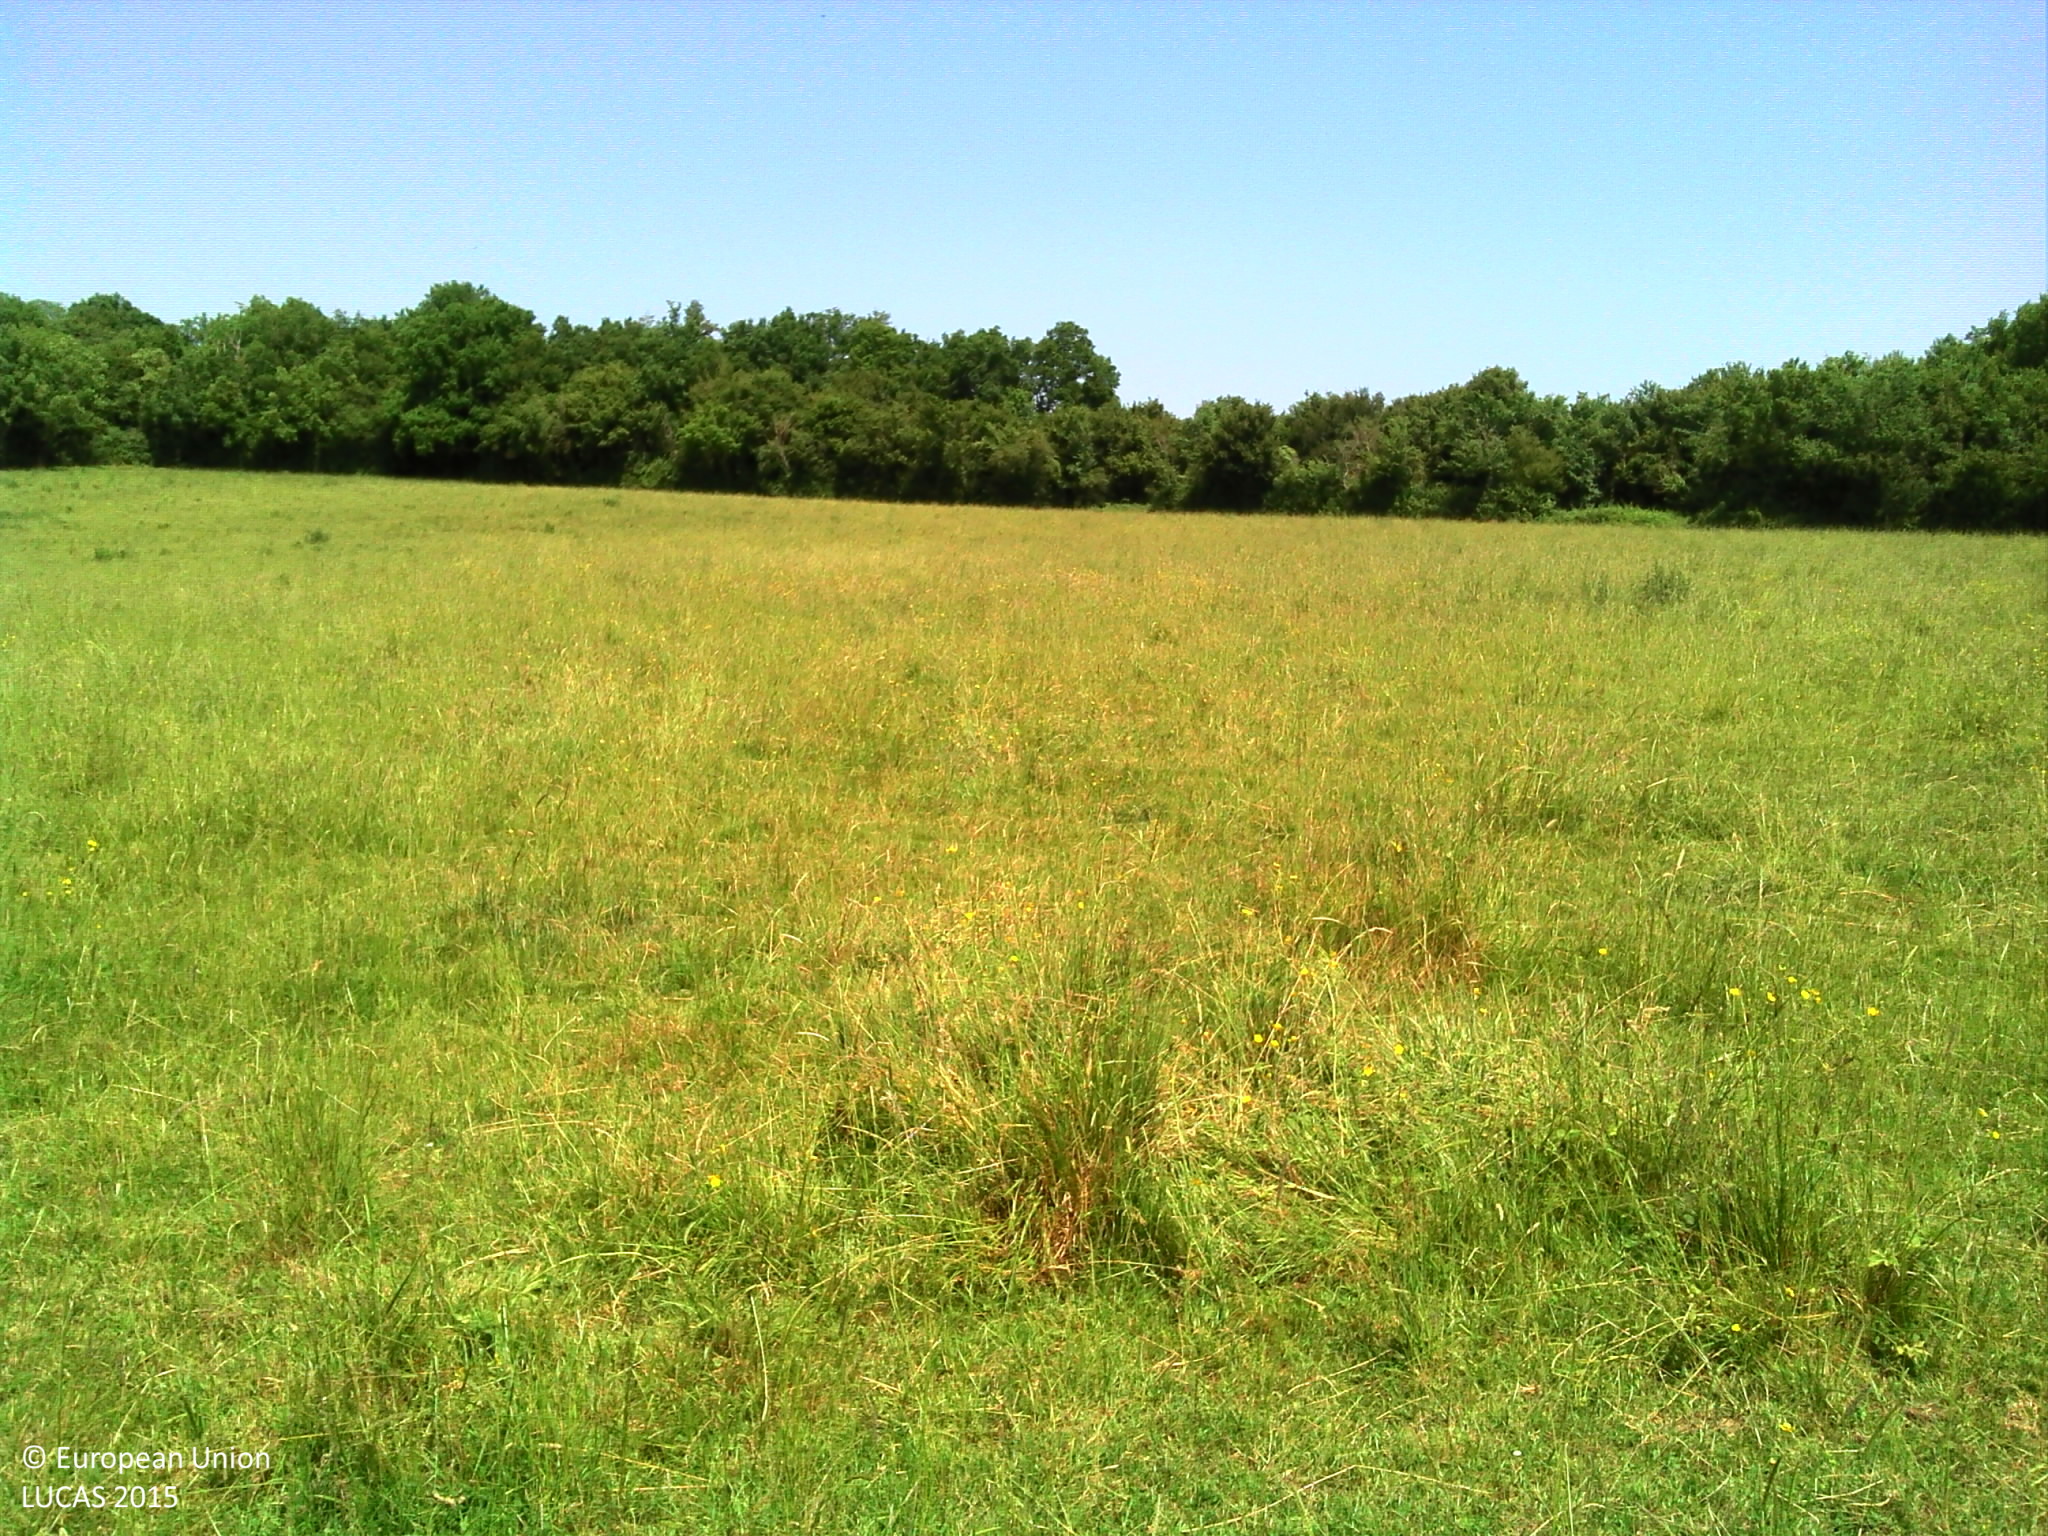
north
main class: Grassland
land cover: Grassland without tree/shrub cover
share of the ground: > 75 %
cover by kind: herbaceous plants 100 %
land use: Agriculture (excluding fallow land and kitchen gardens)
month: June
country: FR
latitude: 46.8279
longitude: 2.7457
